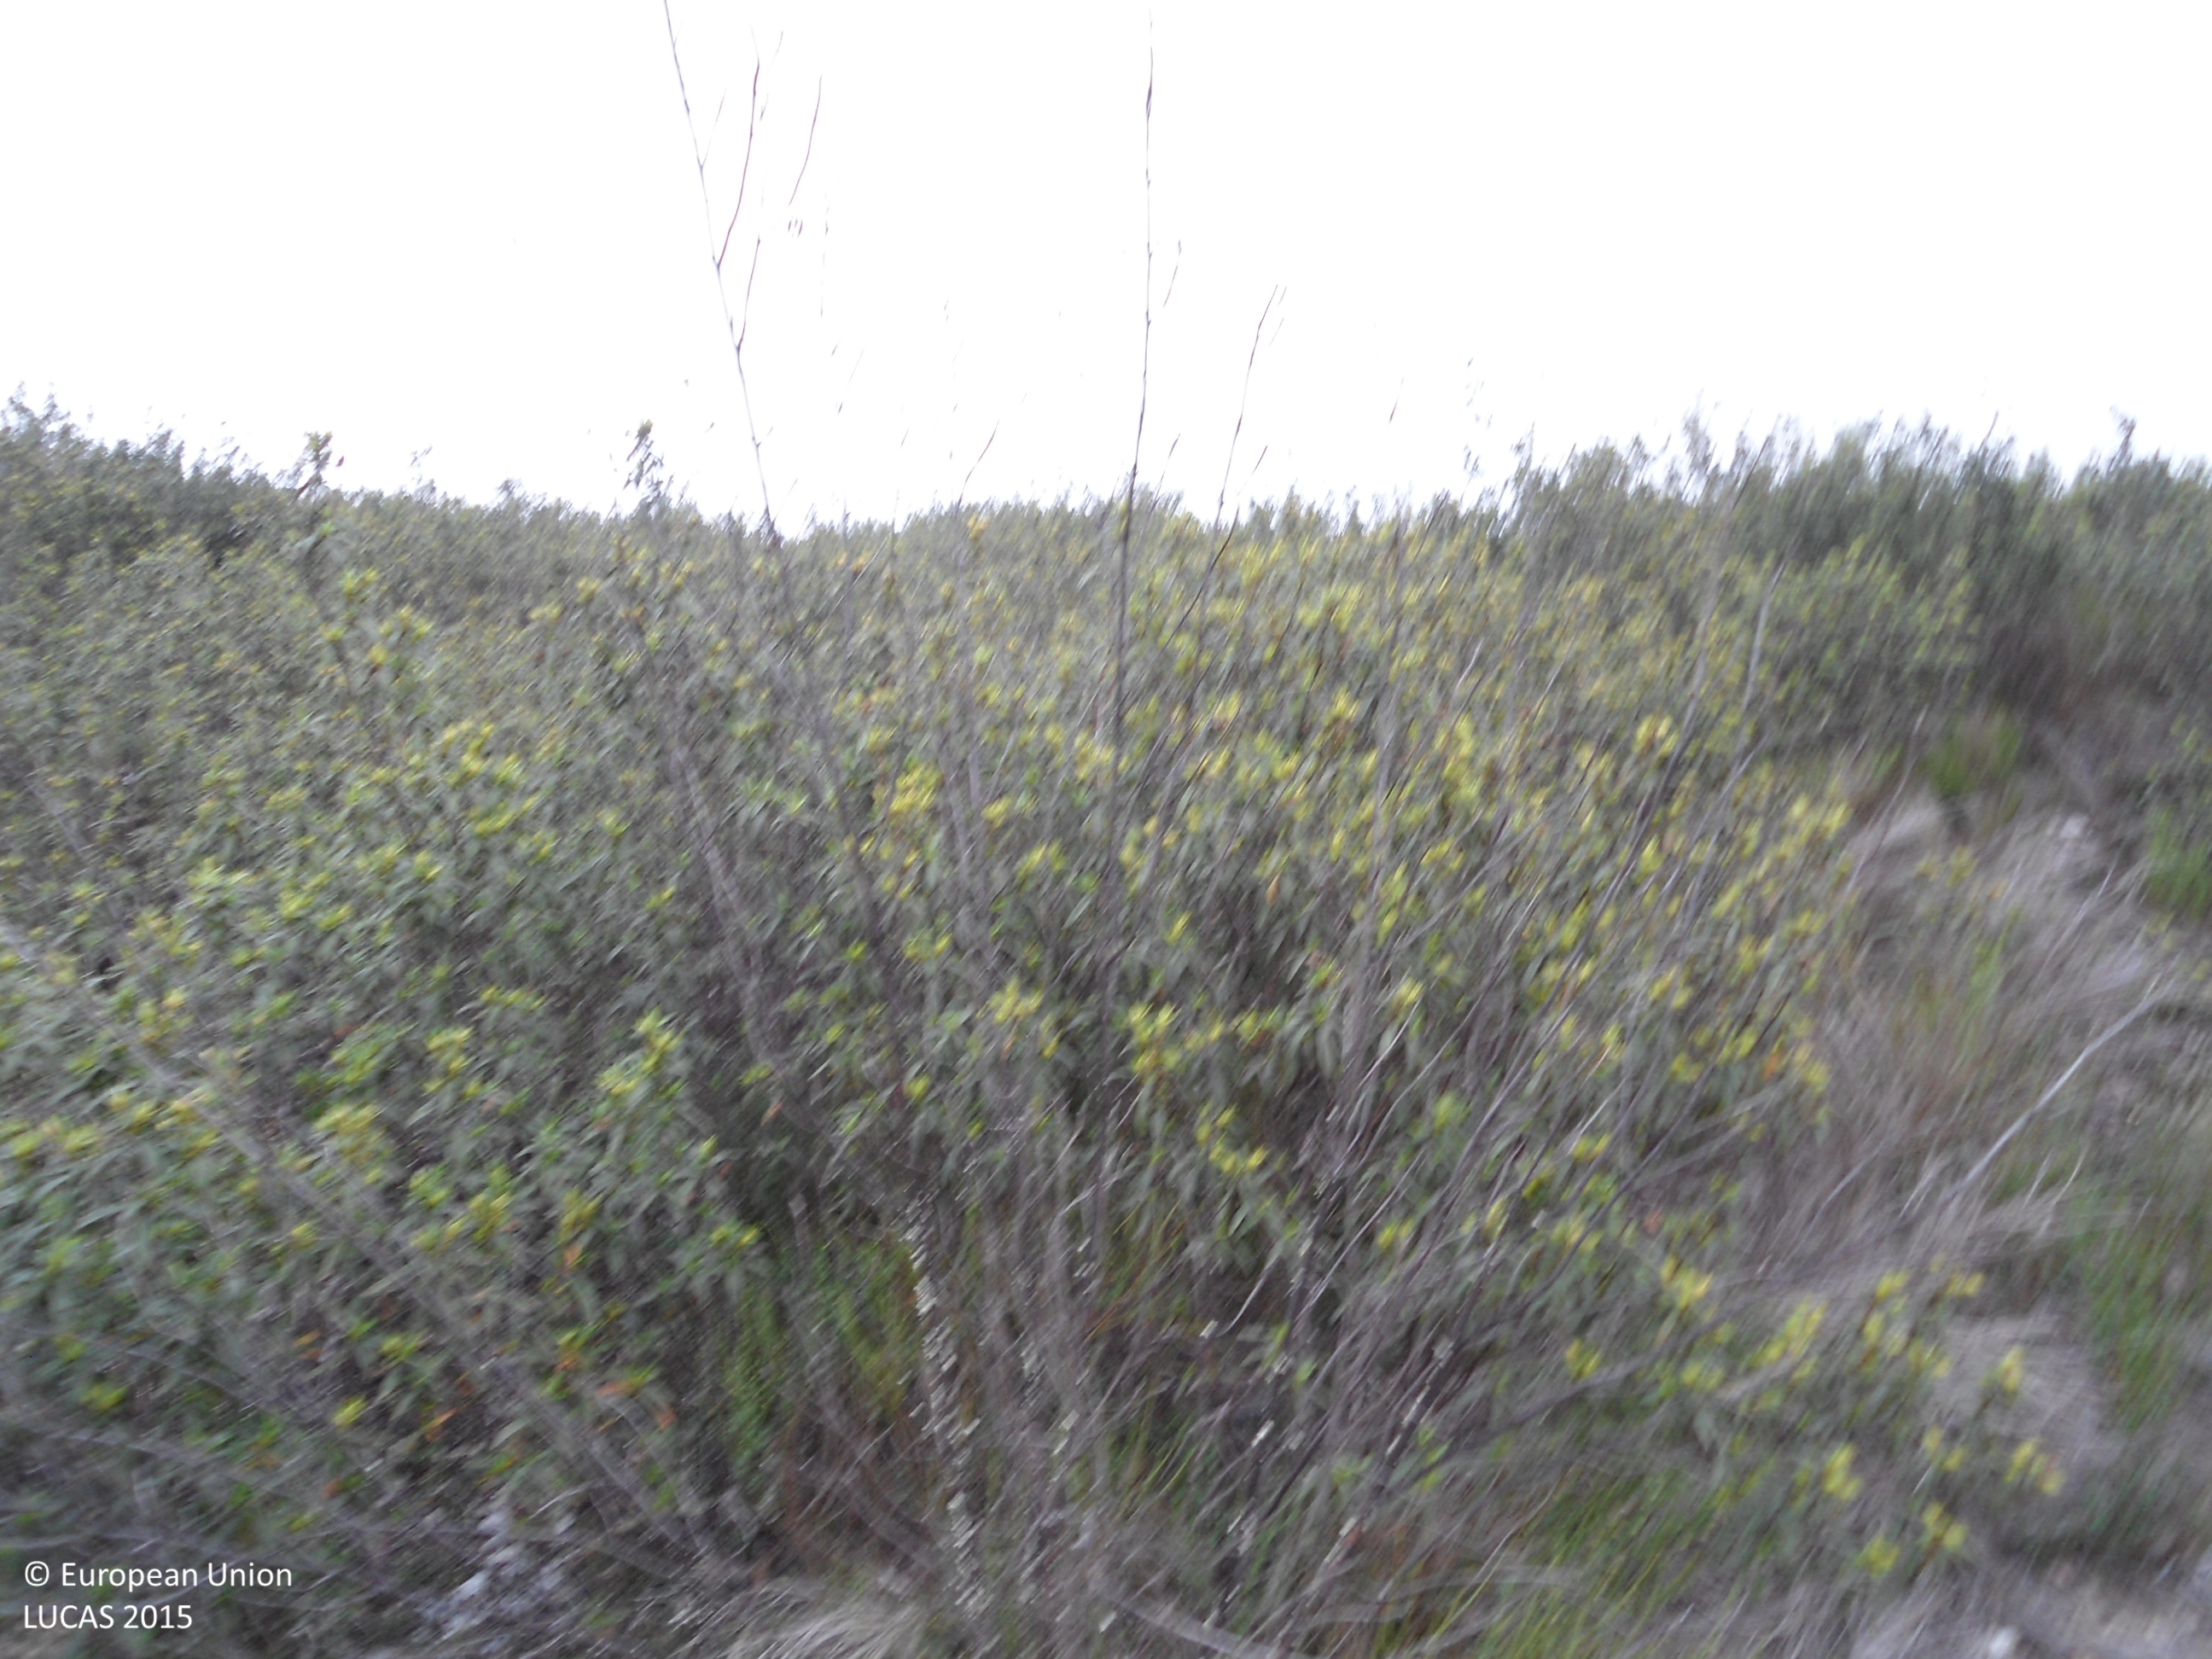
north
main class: Shrubland
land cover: Shrubland without tree cover
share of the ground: > 75 %
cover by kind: shrubs 95 %, consolidated bare surface 5 %
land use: Semi-natural and natural areas not in use
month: April
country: ES
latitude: 41.7893
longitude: -6.4836
